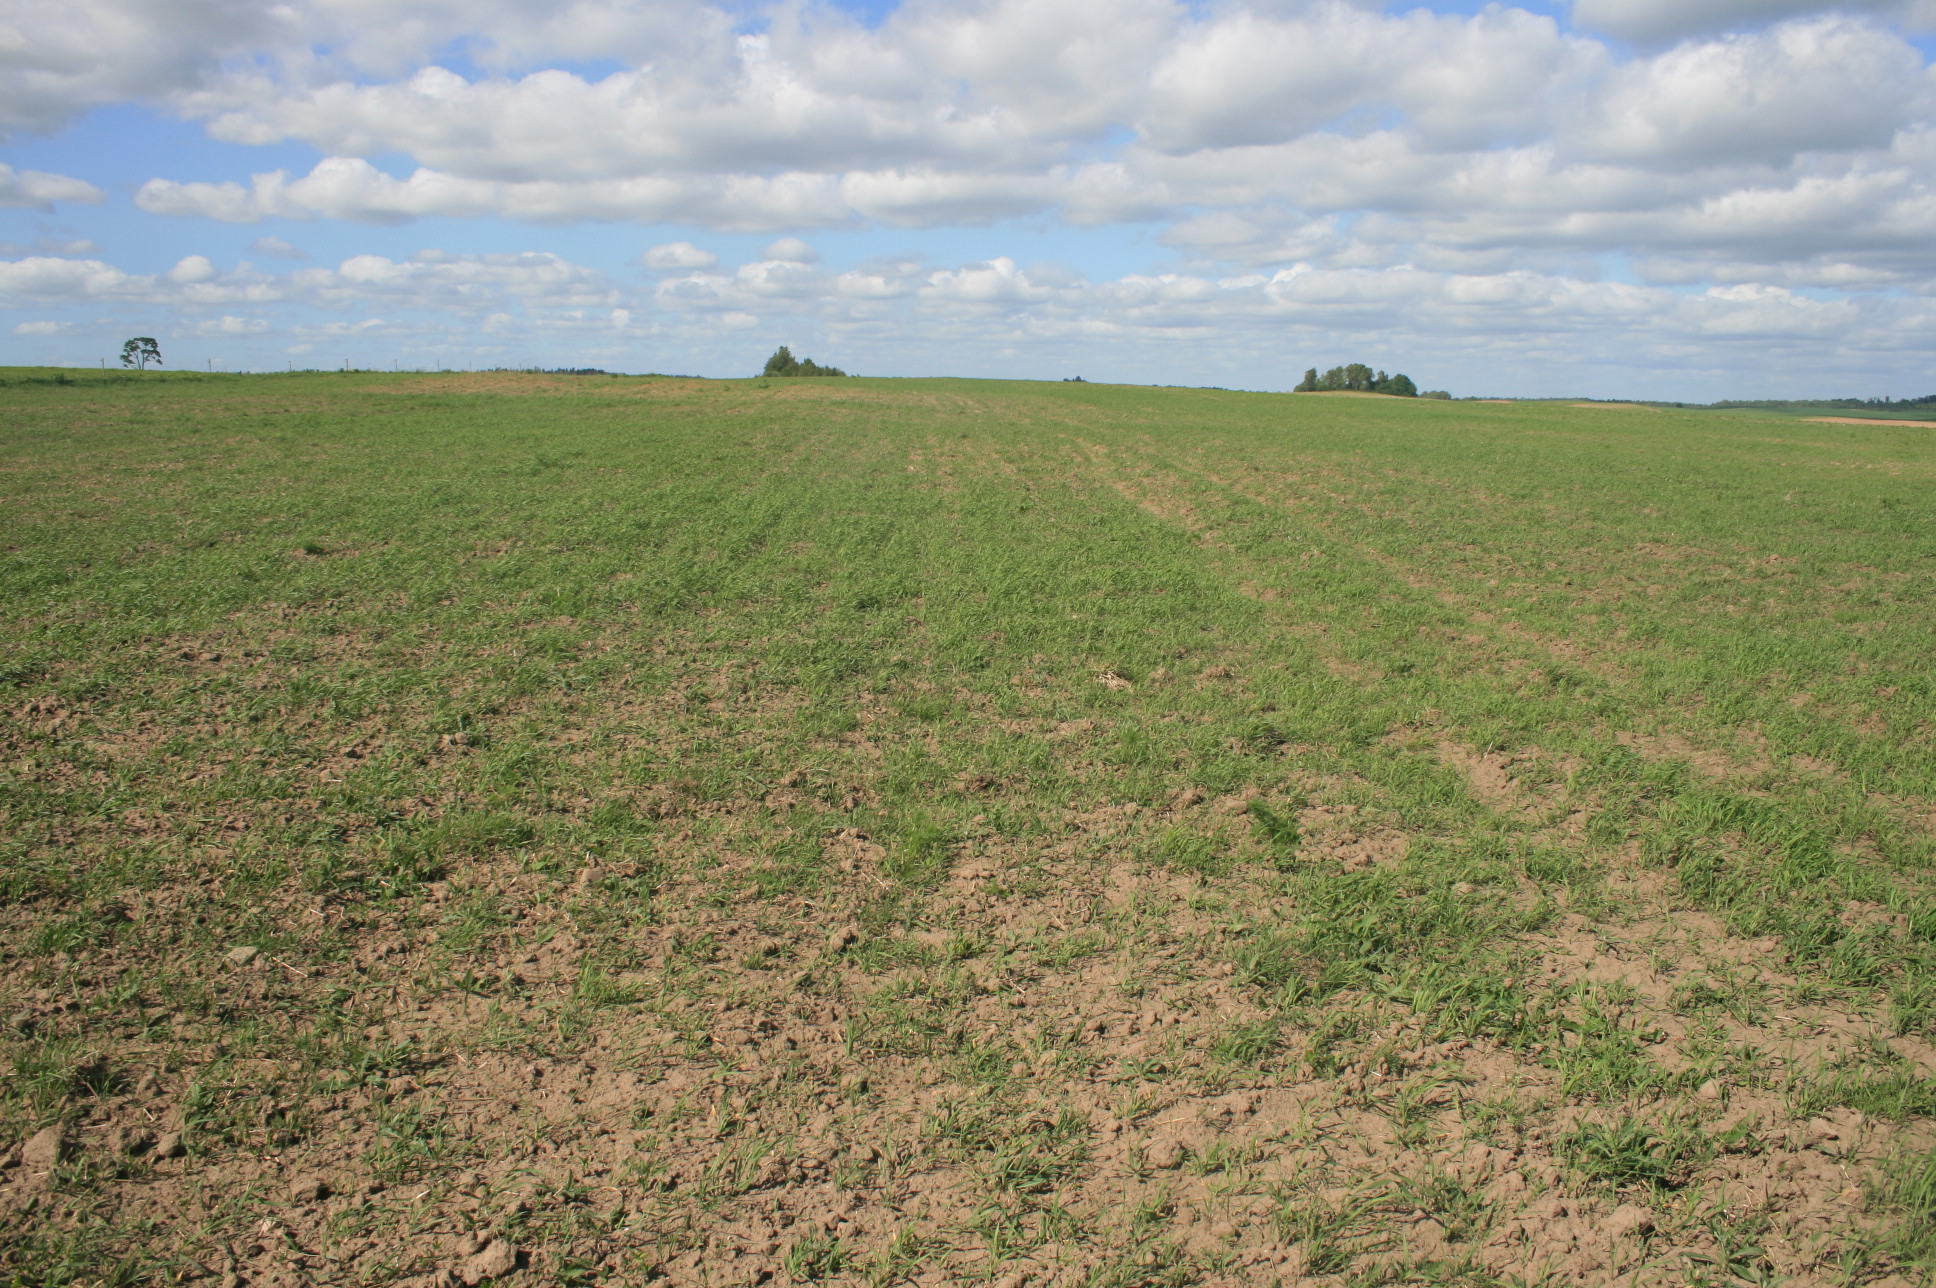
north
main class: Cropland
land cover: Barley
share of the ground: > 75 %
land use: Agriculture (excluding fallow land and kitchen gardens)
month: June
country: LT
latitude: 56.0449
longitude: 22.3373
